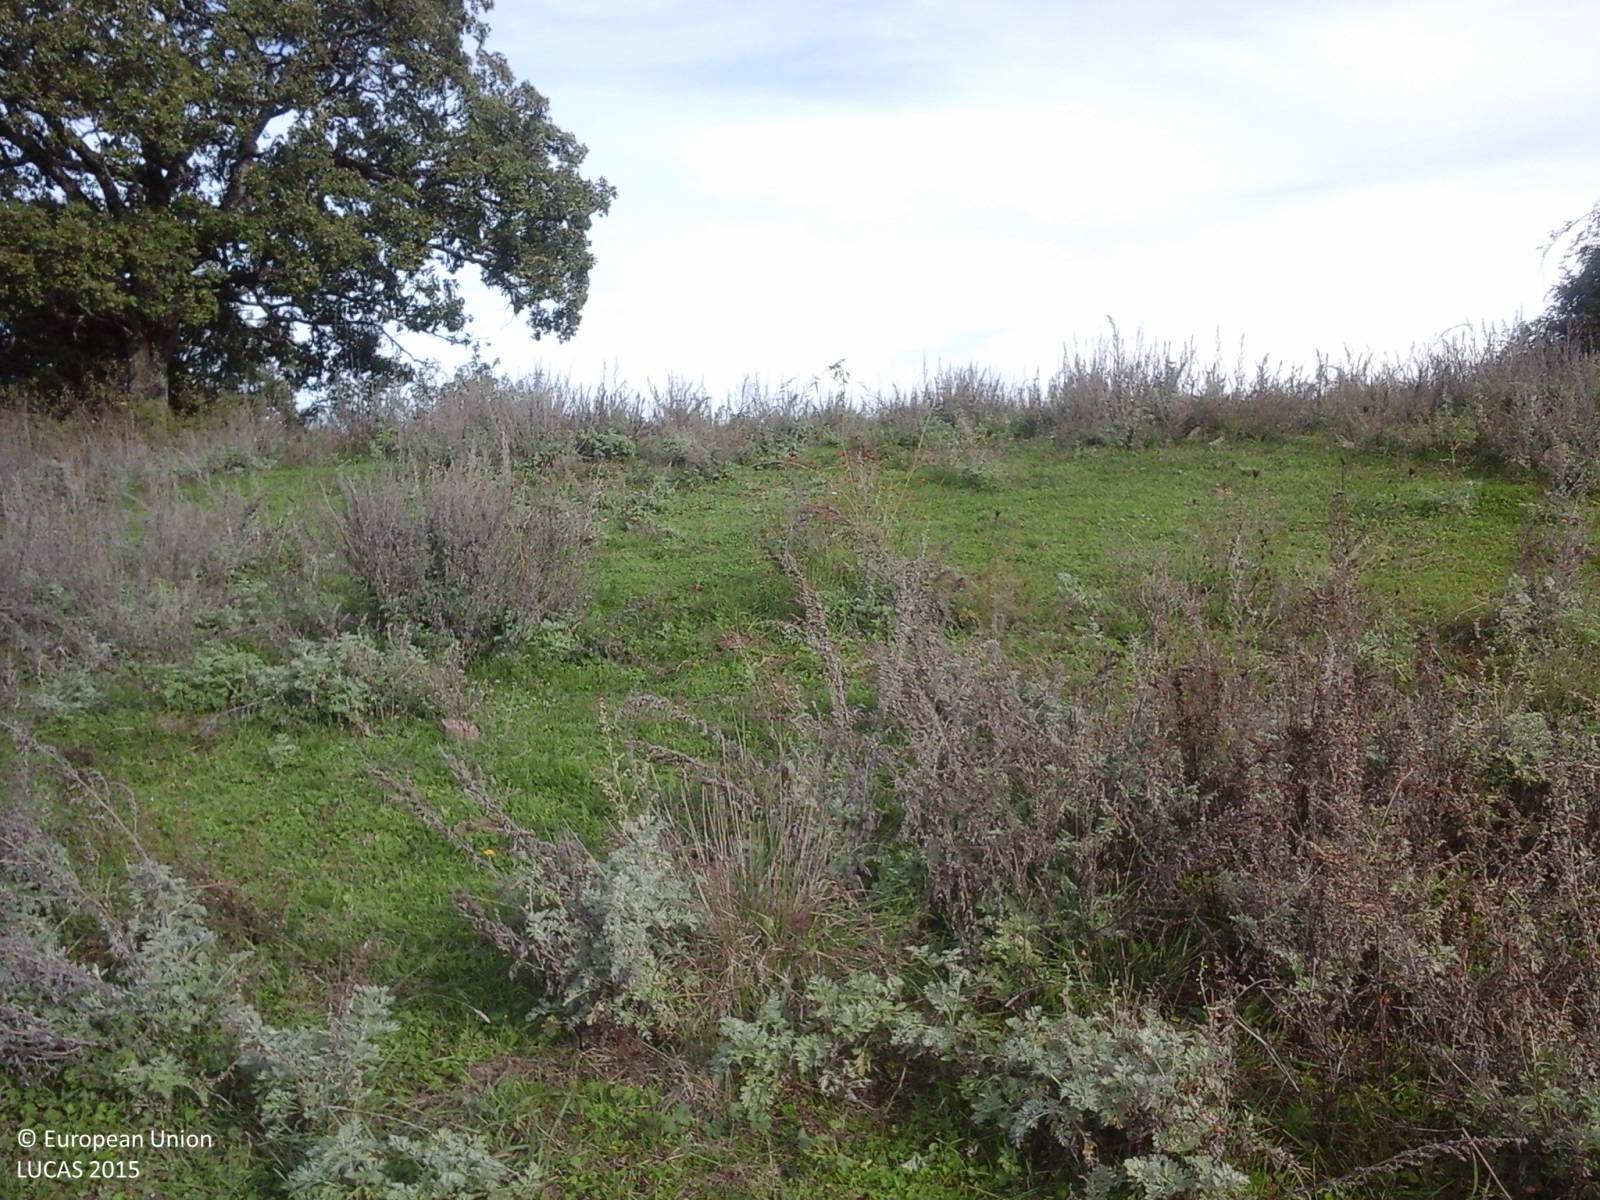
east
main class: Woodland
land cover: Broadleaved woodland
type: thermophilous deciduous forest
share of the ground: > 75 %
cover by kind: broadleaved forest trees 100 %
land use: Forestry
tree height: > 5 m
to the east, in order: Broadleaved woodland
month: October
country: IT
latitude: 42.8276
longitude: 12.2560
